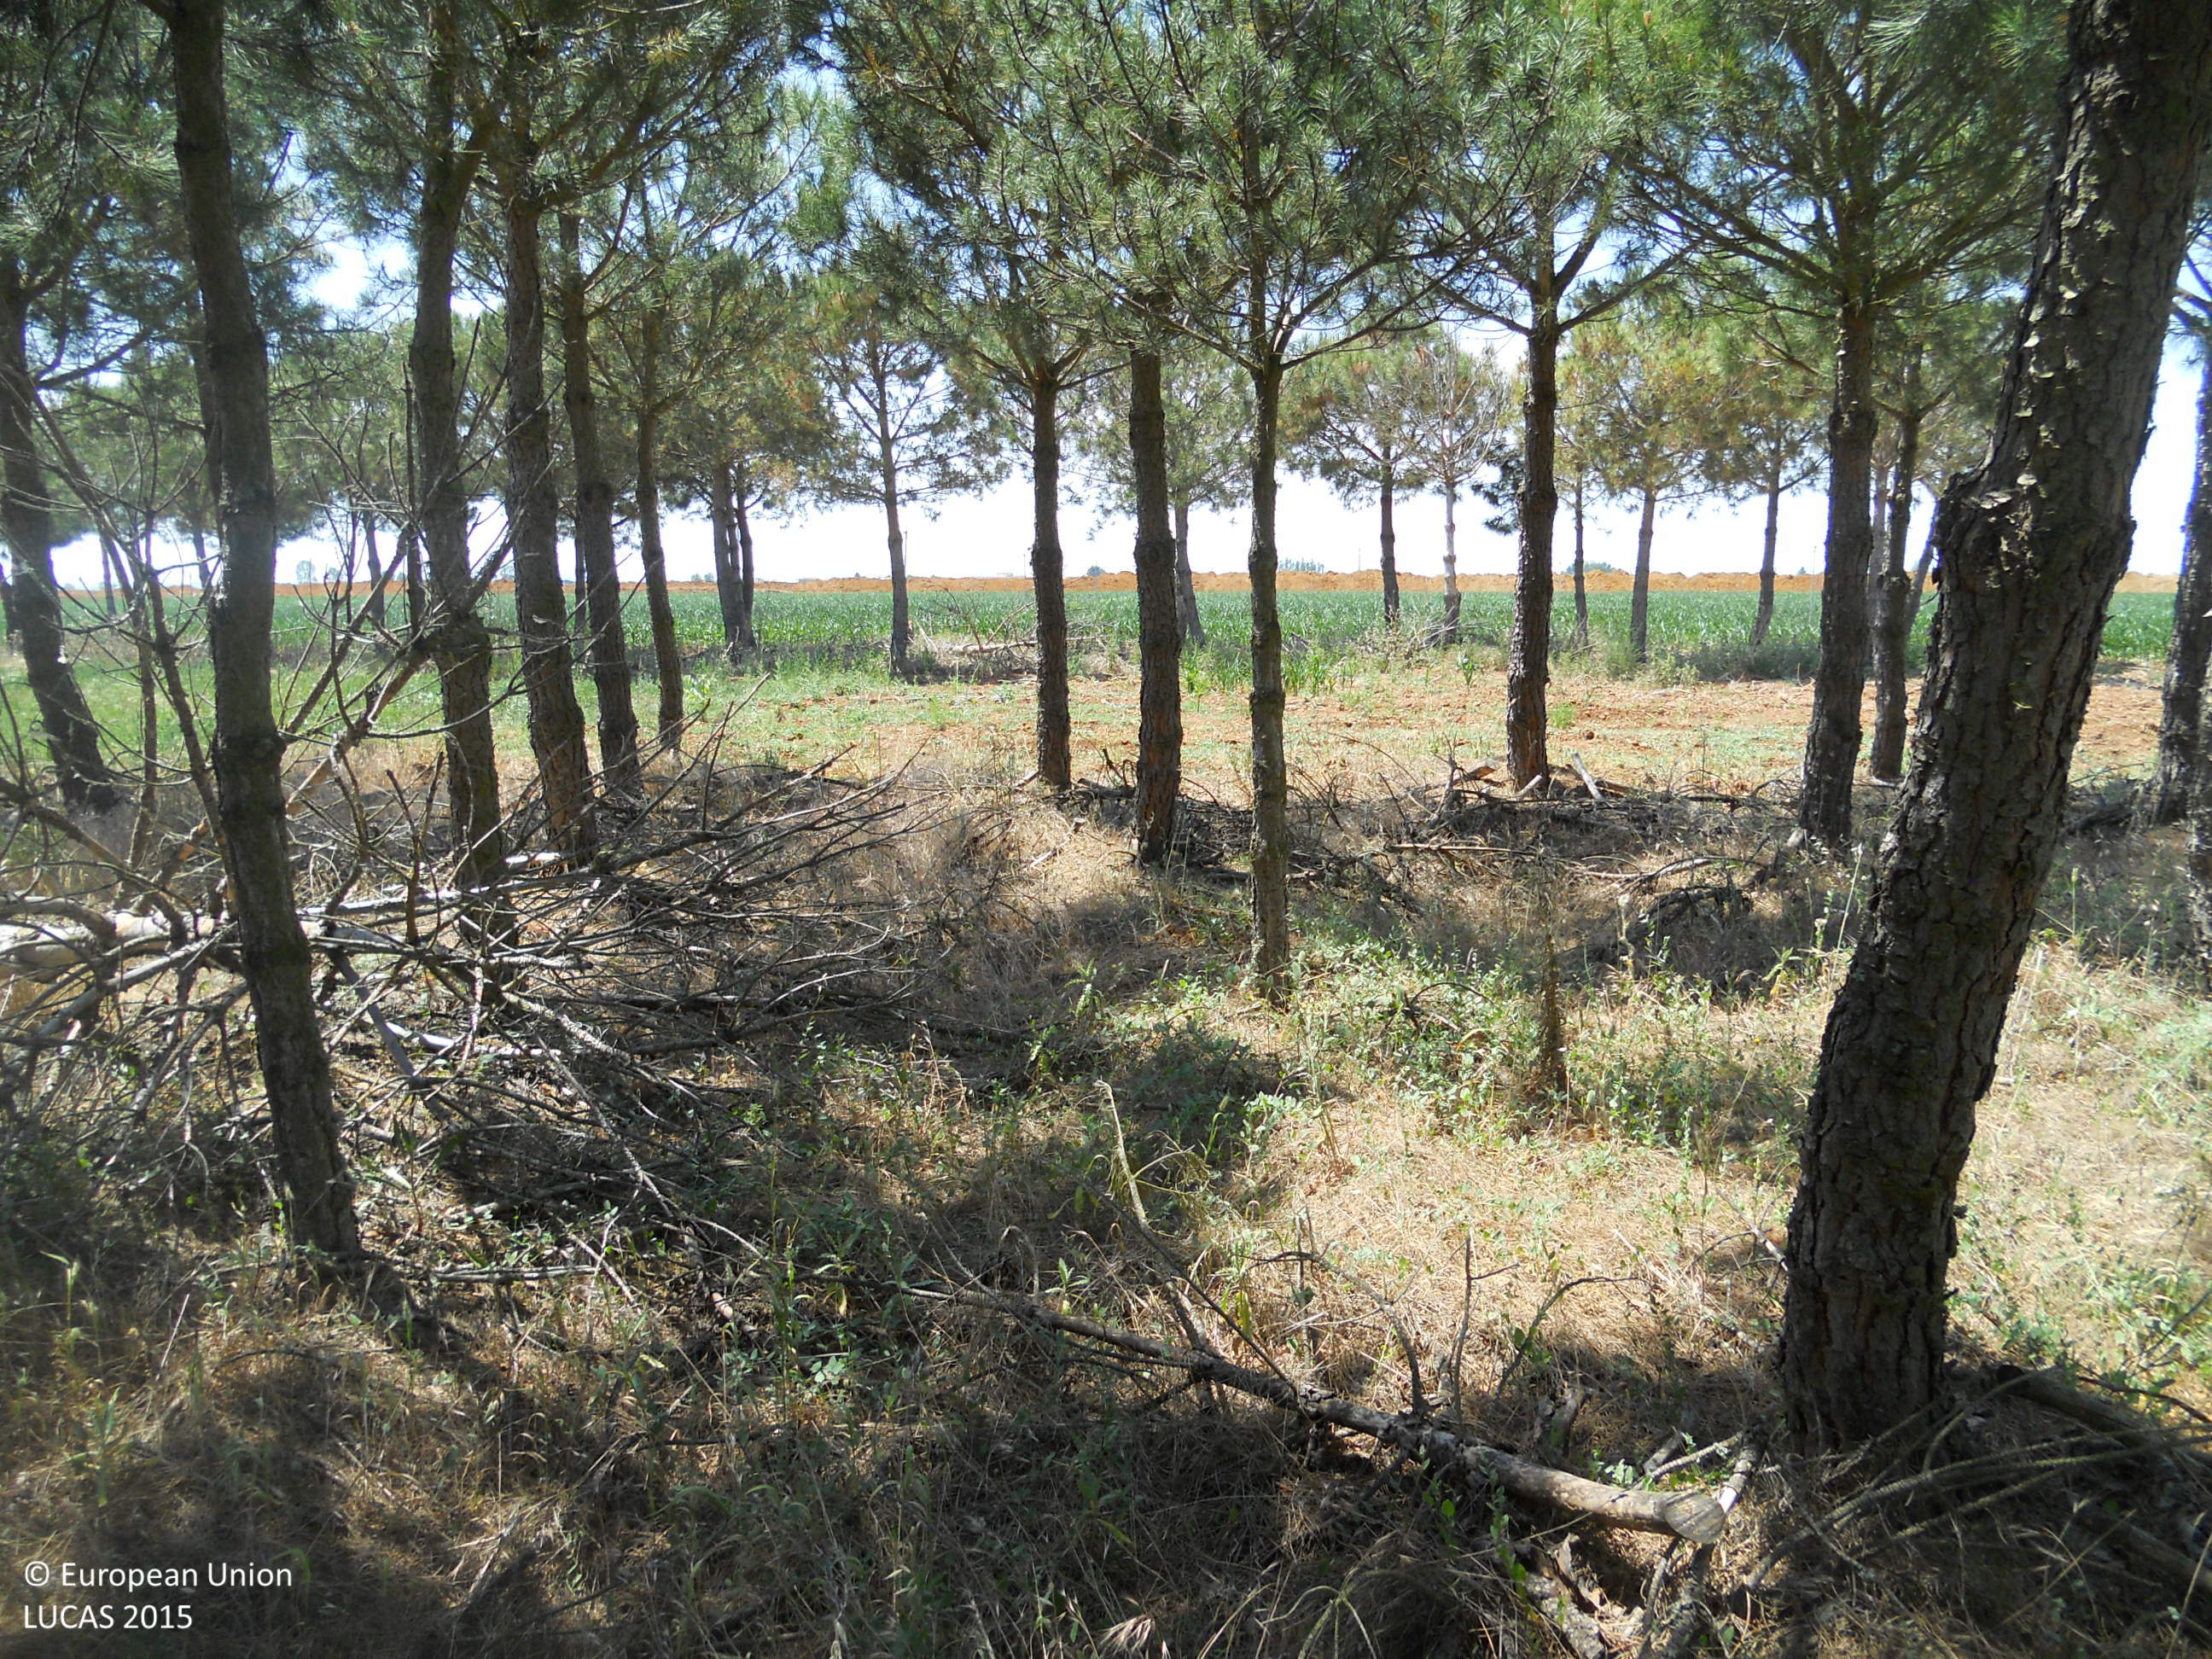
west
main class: Woodland
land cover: Pine dominated coniferous woodland
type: coniferous forest of the mediterranean region
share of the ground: > 75 %
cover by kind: coniferous forest trees 80 %, herbaceous plants 20 %
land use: Forestry
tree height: < 5 m
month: June
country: ES
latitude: 42.3084
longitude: -5.6602
